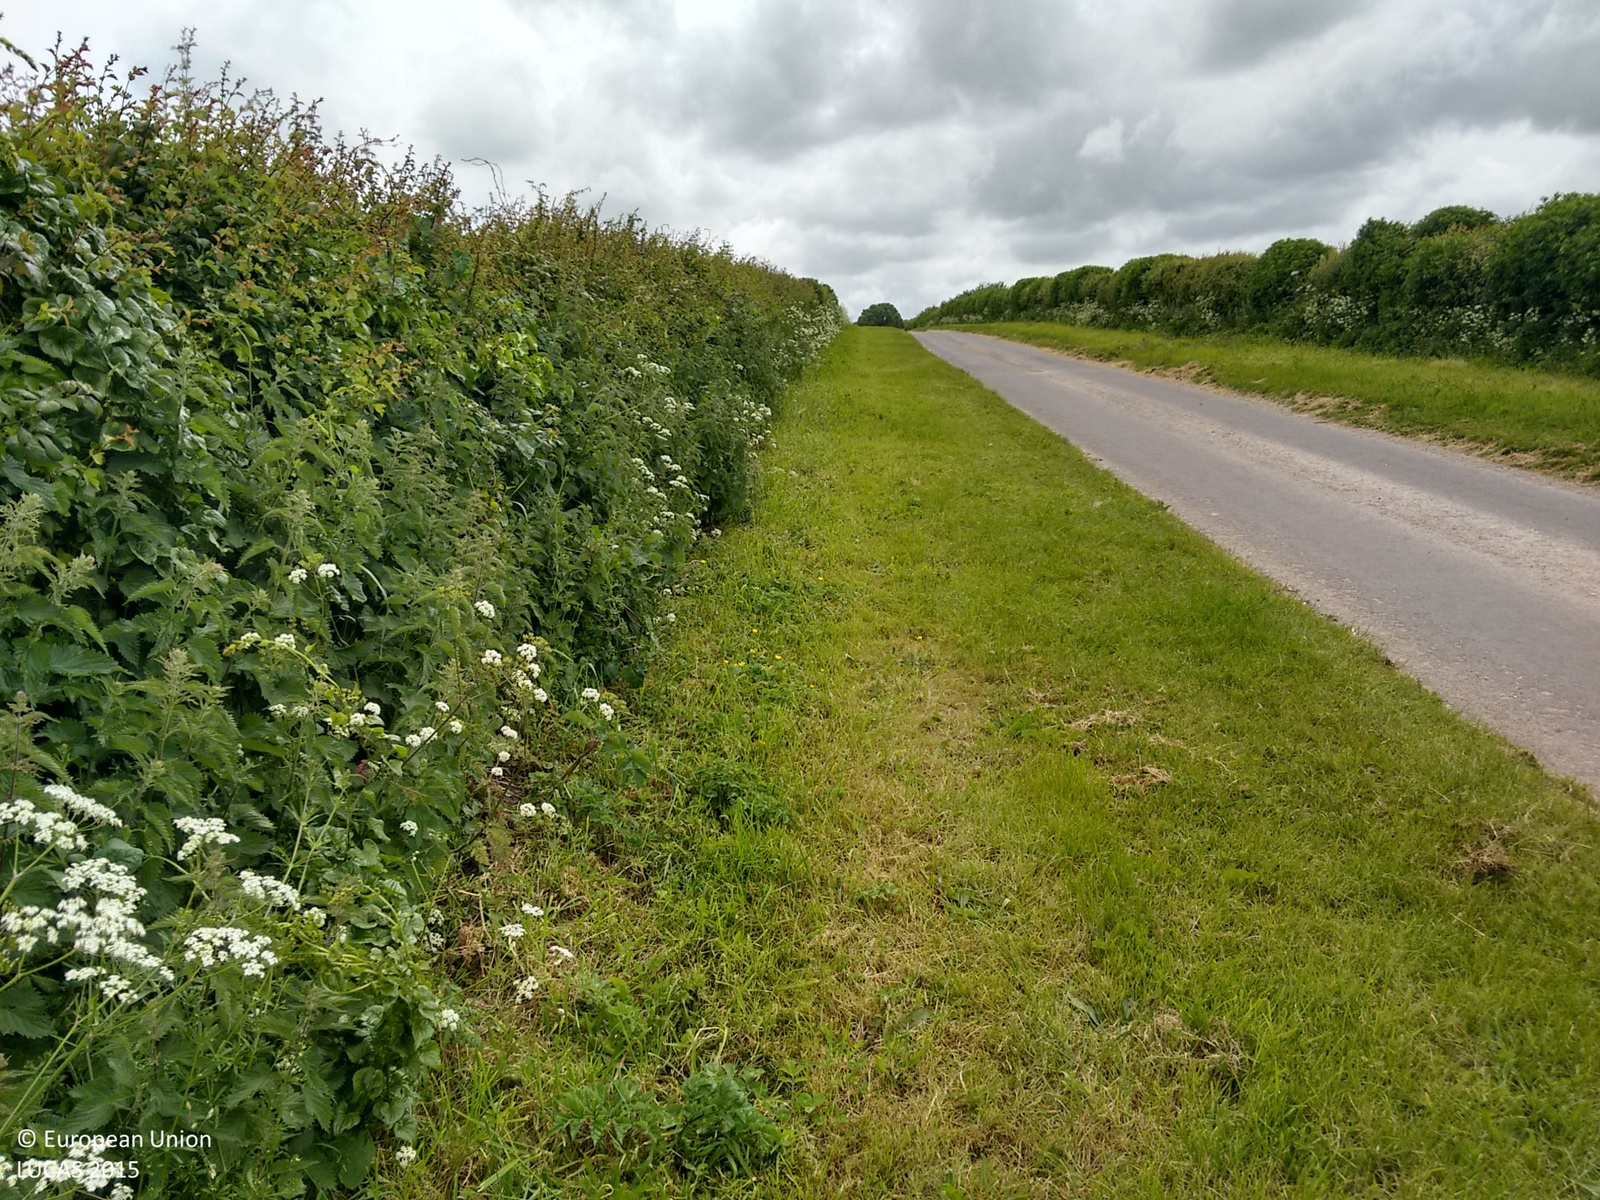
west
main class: Cropland
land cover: Barley
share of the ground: > 75 %
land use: Agriculture (excluding fallow land and kitchen gardens)
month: June
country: GB
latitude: 50.7792
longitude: -2.3887
